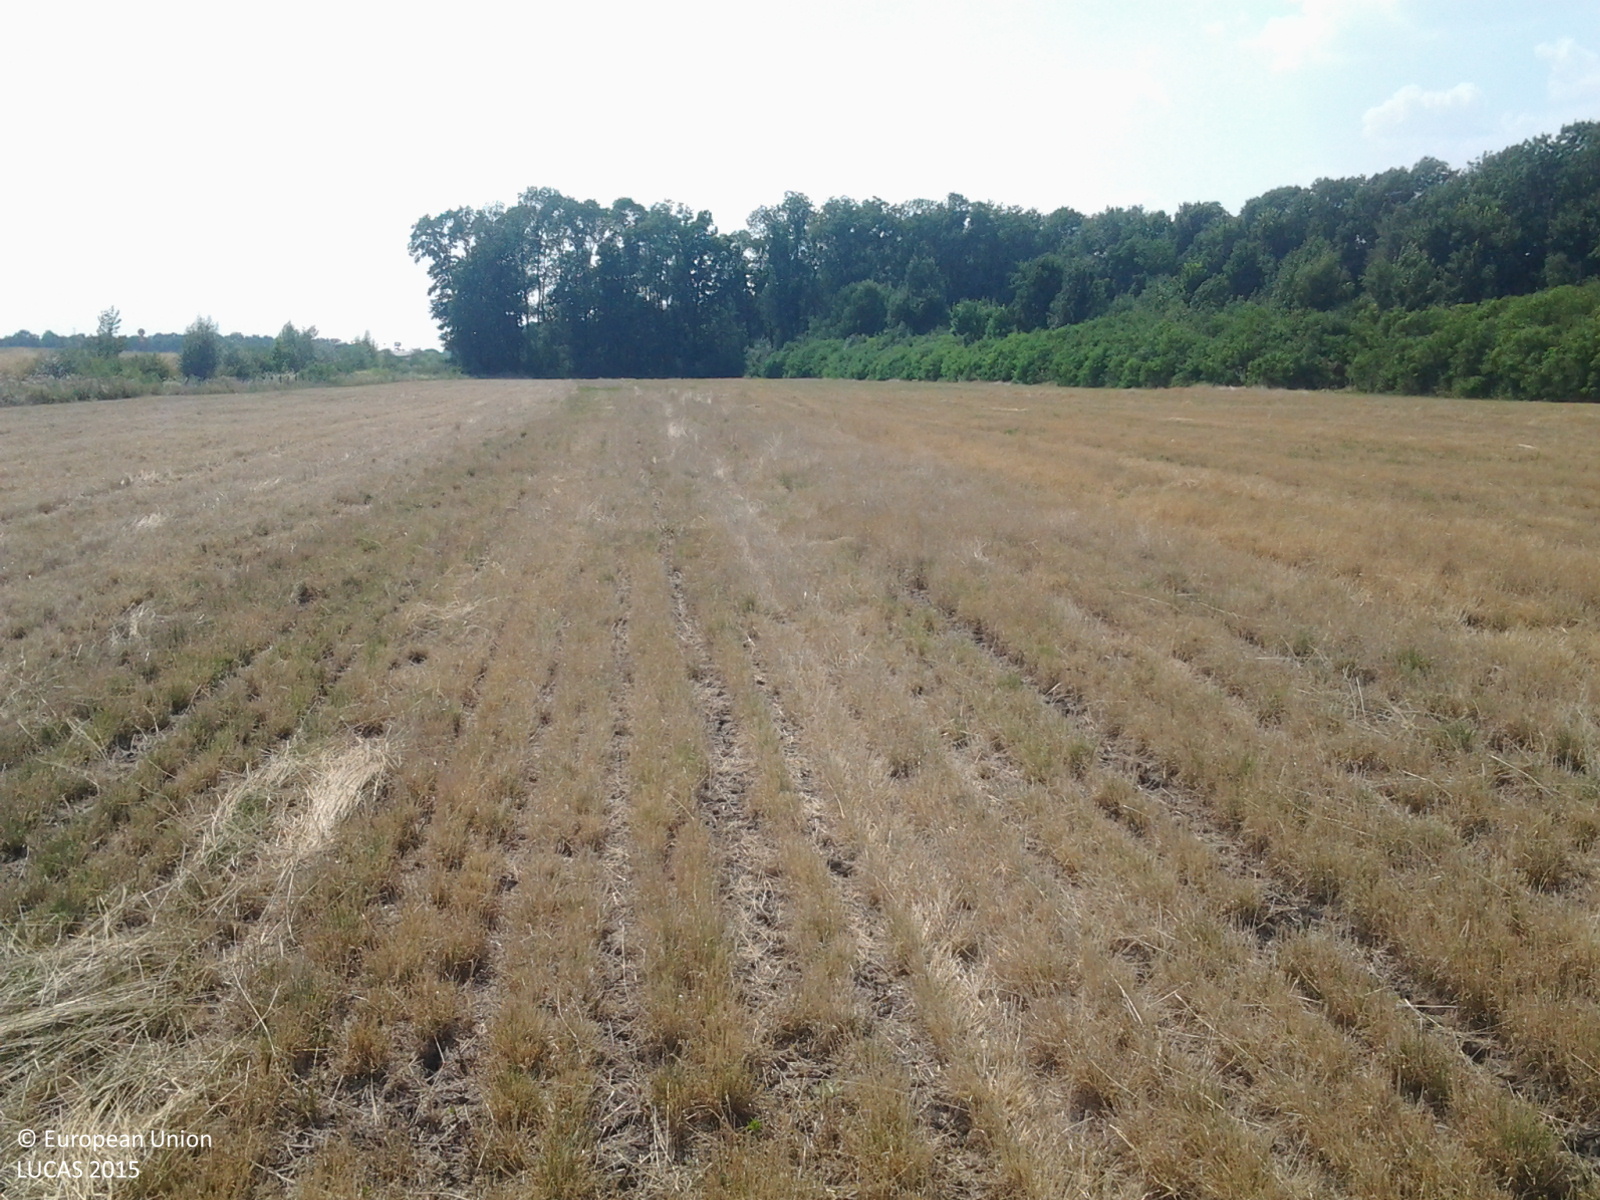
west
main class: Cropland
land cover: Common wheat
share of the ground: < 10 %
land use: Agriculture (excluding fallow land and kitchen gardens)
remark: Harvested field
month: July
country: HU
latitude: 47.2454
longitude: 20.7205
